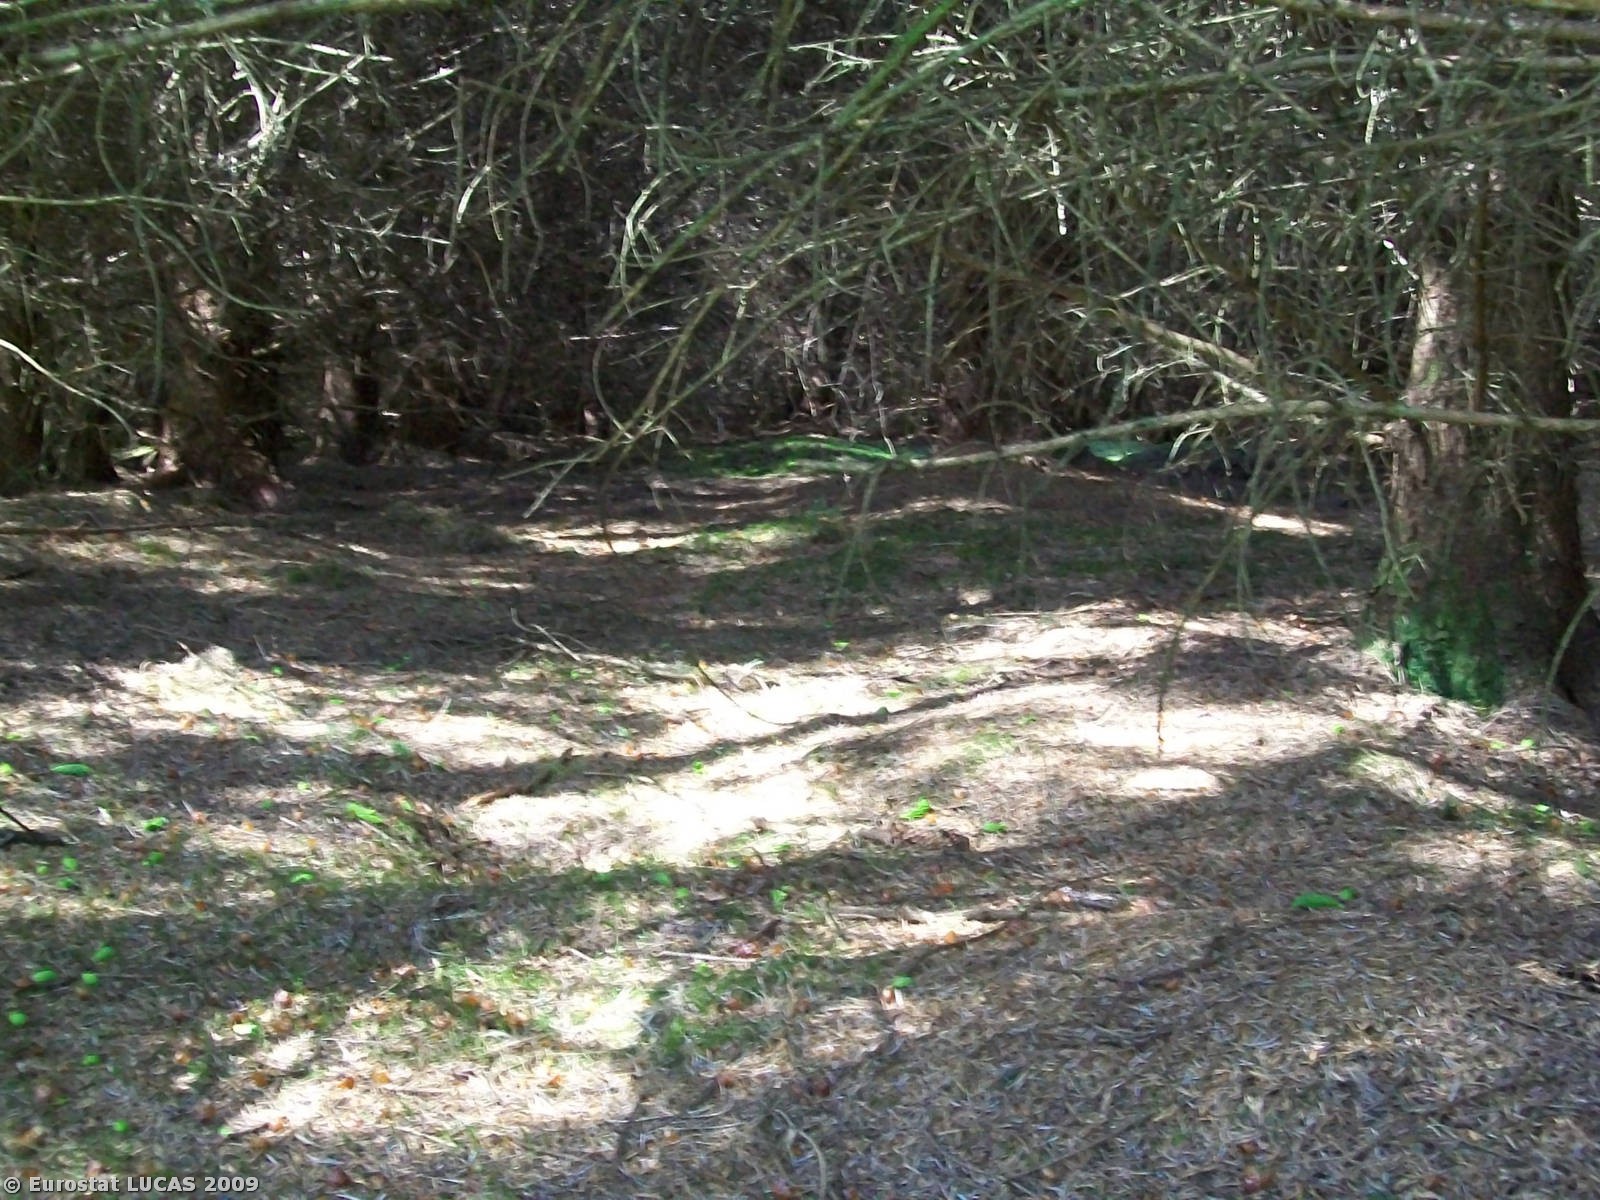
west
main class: Woodland
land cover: Coniferous woodland
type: plantations and self-sown exotic forest
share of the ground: > 75 %
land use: Forestry
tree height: > 5 m
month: May
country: GB
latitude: 55.0973
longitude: -6.8539
